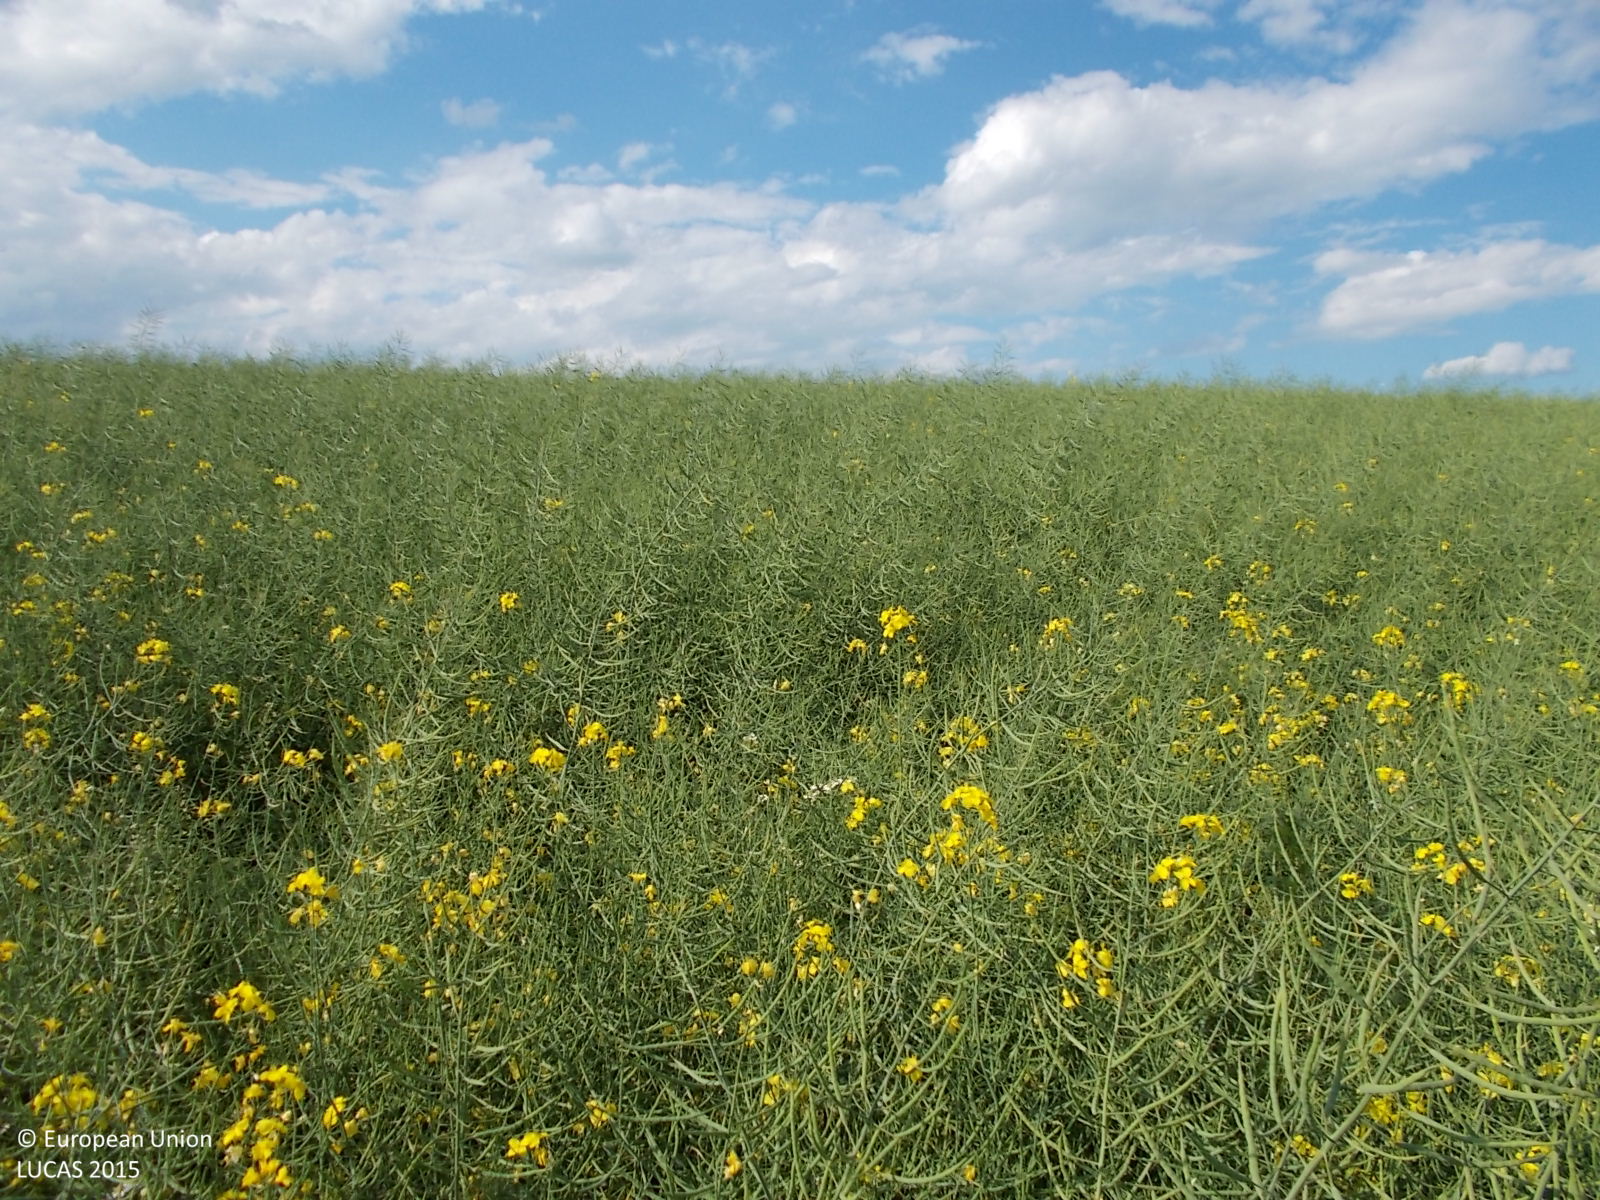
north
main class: Cropland
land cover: Rape and turnip rape
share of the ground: > 75 %
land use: Agriculture (excluding fallow land and kitchen gardens)
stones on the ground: < 10 %
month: June
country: CZ
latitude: 49.9420
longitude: 15.1448
